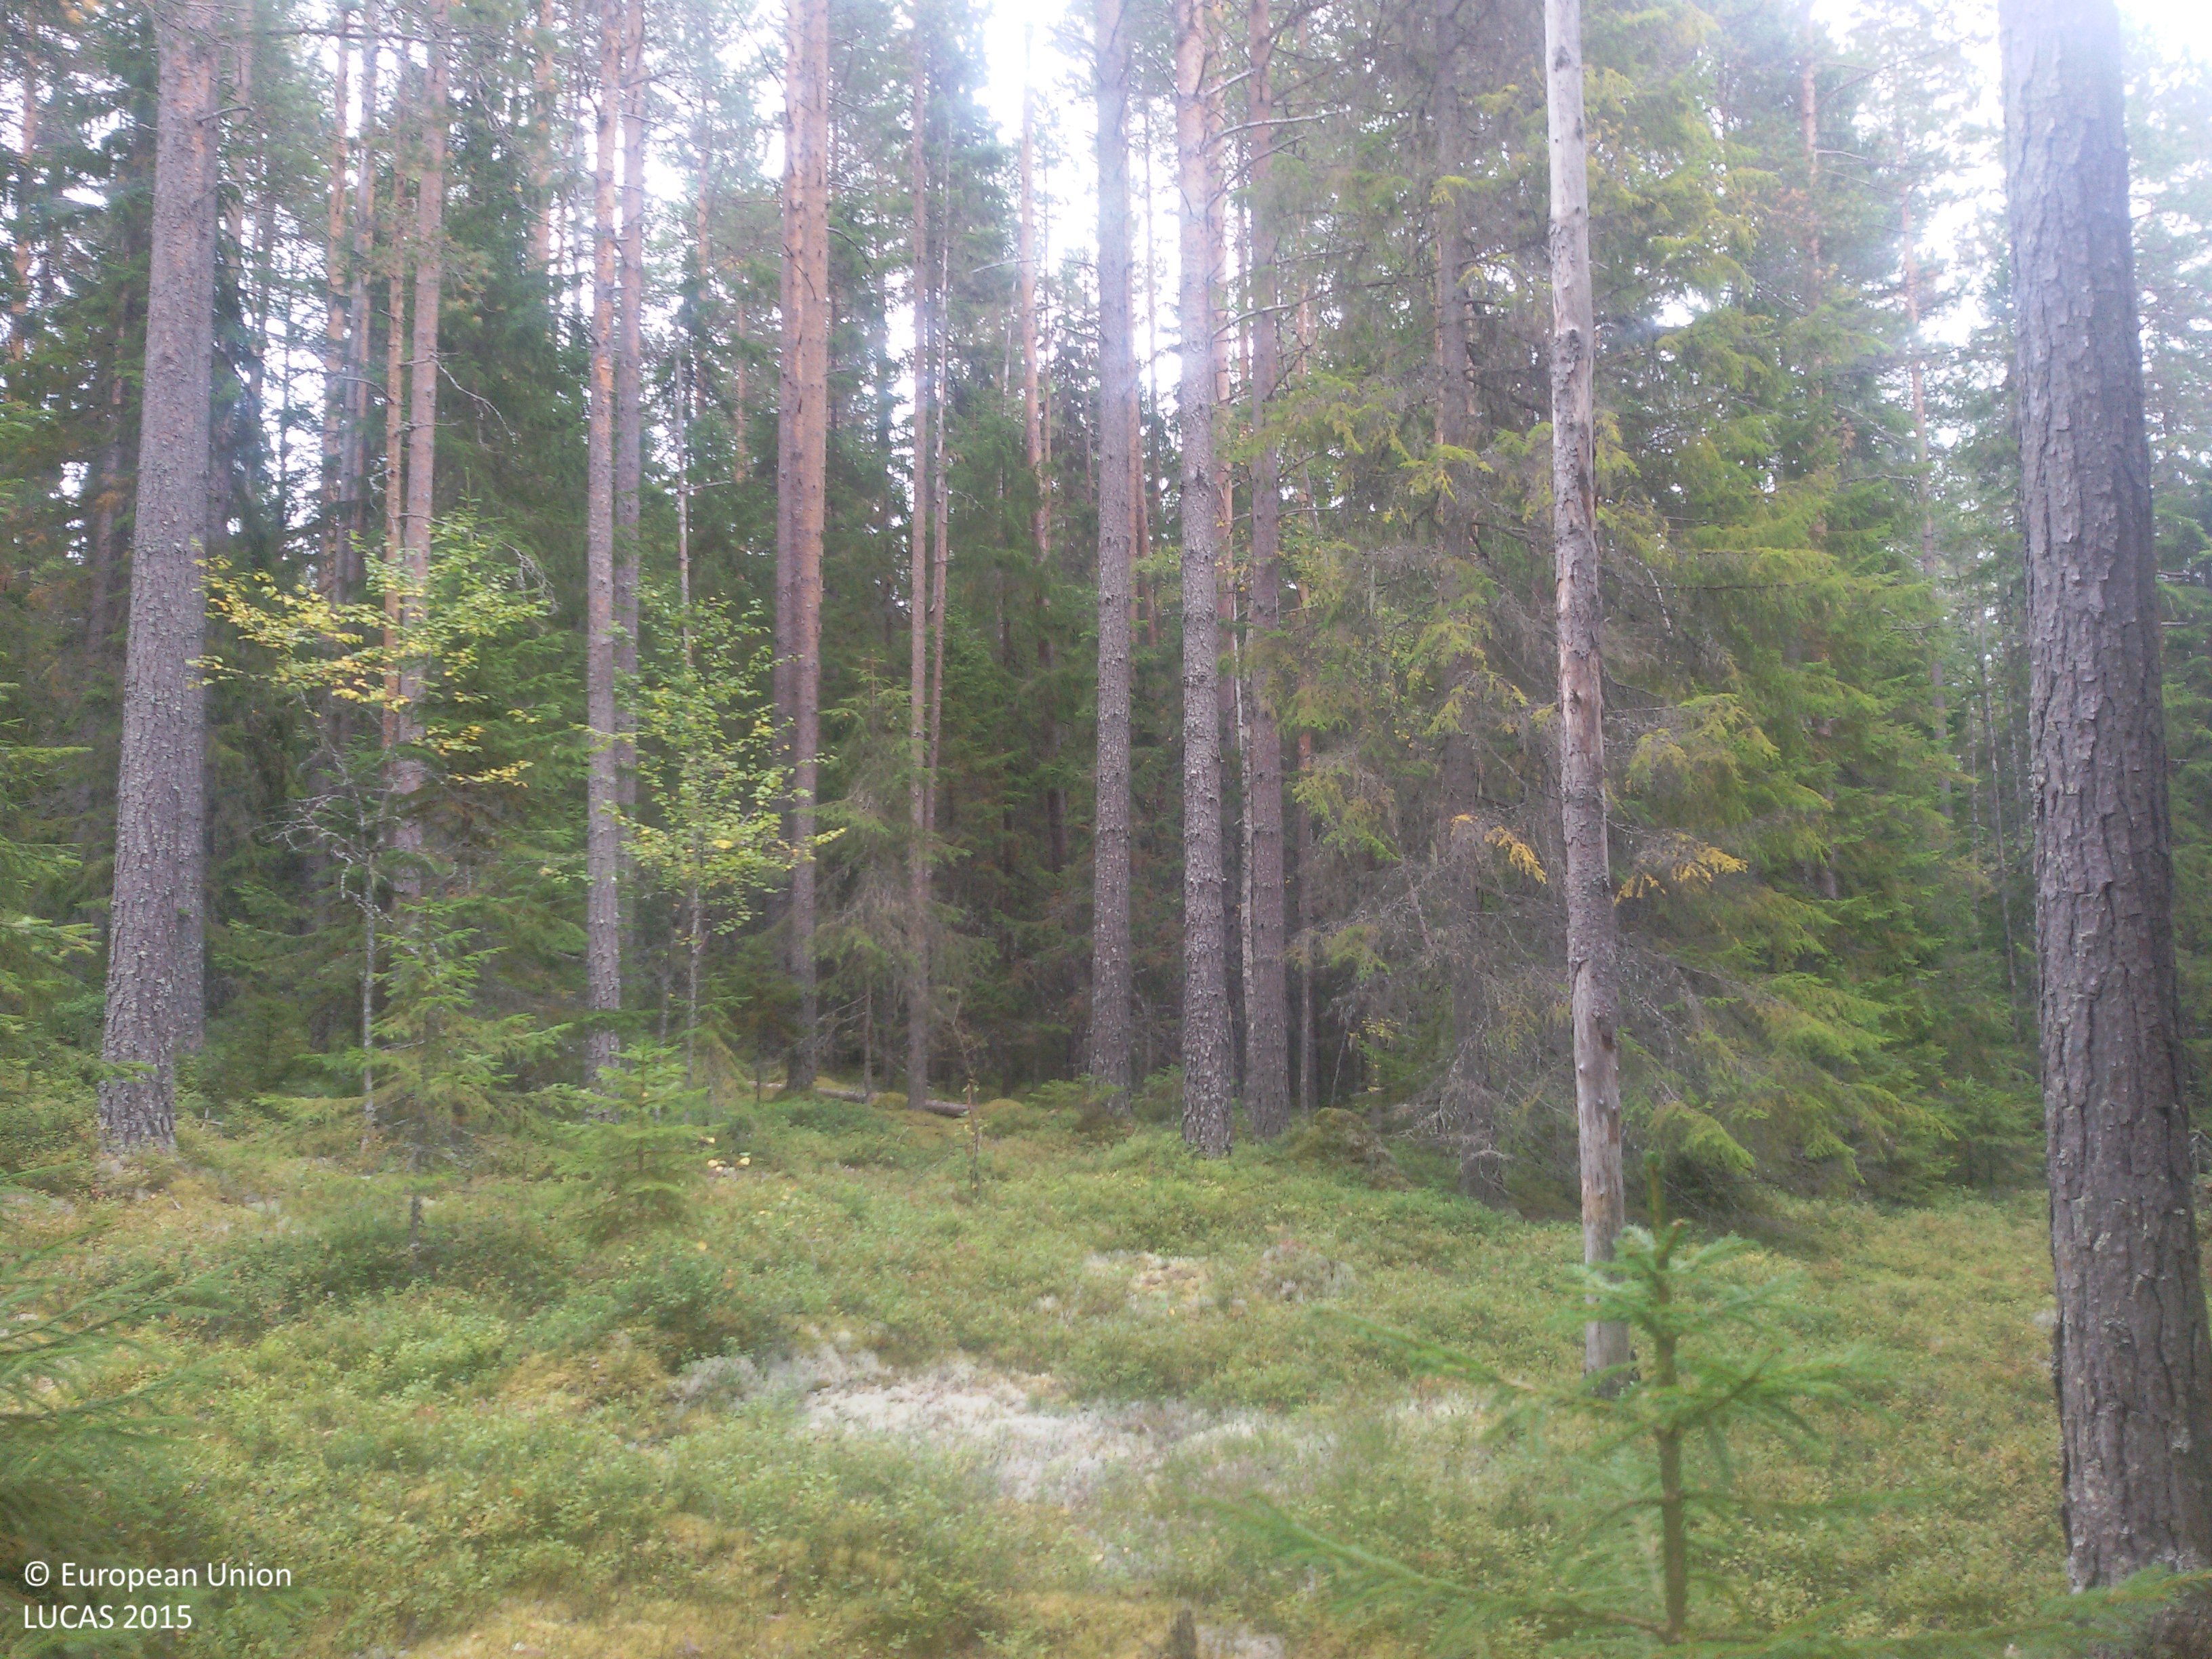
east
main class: Woodland
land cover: Pine dominated coniferous woodland
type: boreal forest
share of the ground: 50 - 75 %
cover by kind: coniferous forest trees 70 %, herbaceous plants 15 %, lichens and mosses 15 %
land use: Forestry
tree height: > 5 m
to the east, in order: Pine dominated coniferous woodland; Spruce dominated coniferous woodland; Pine dominated coniferous woodland; Spruce dominated coniferous woodland; Ditches and canals; Spruce dominated coniferous woodland; Pine dominated coniferous woodland
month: September
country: SE
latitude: 61.0496
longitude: 14.9678
